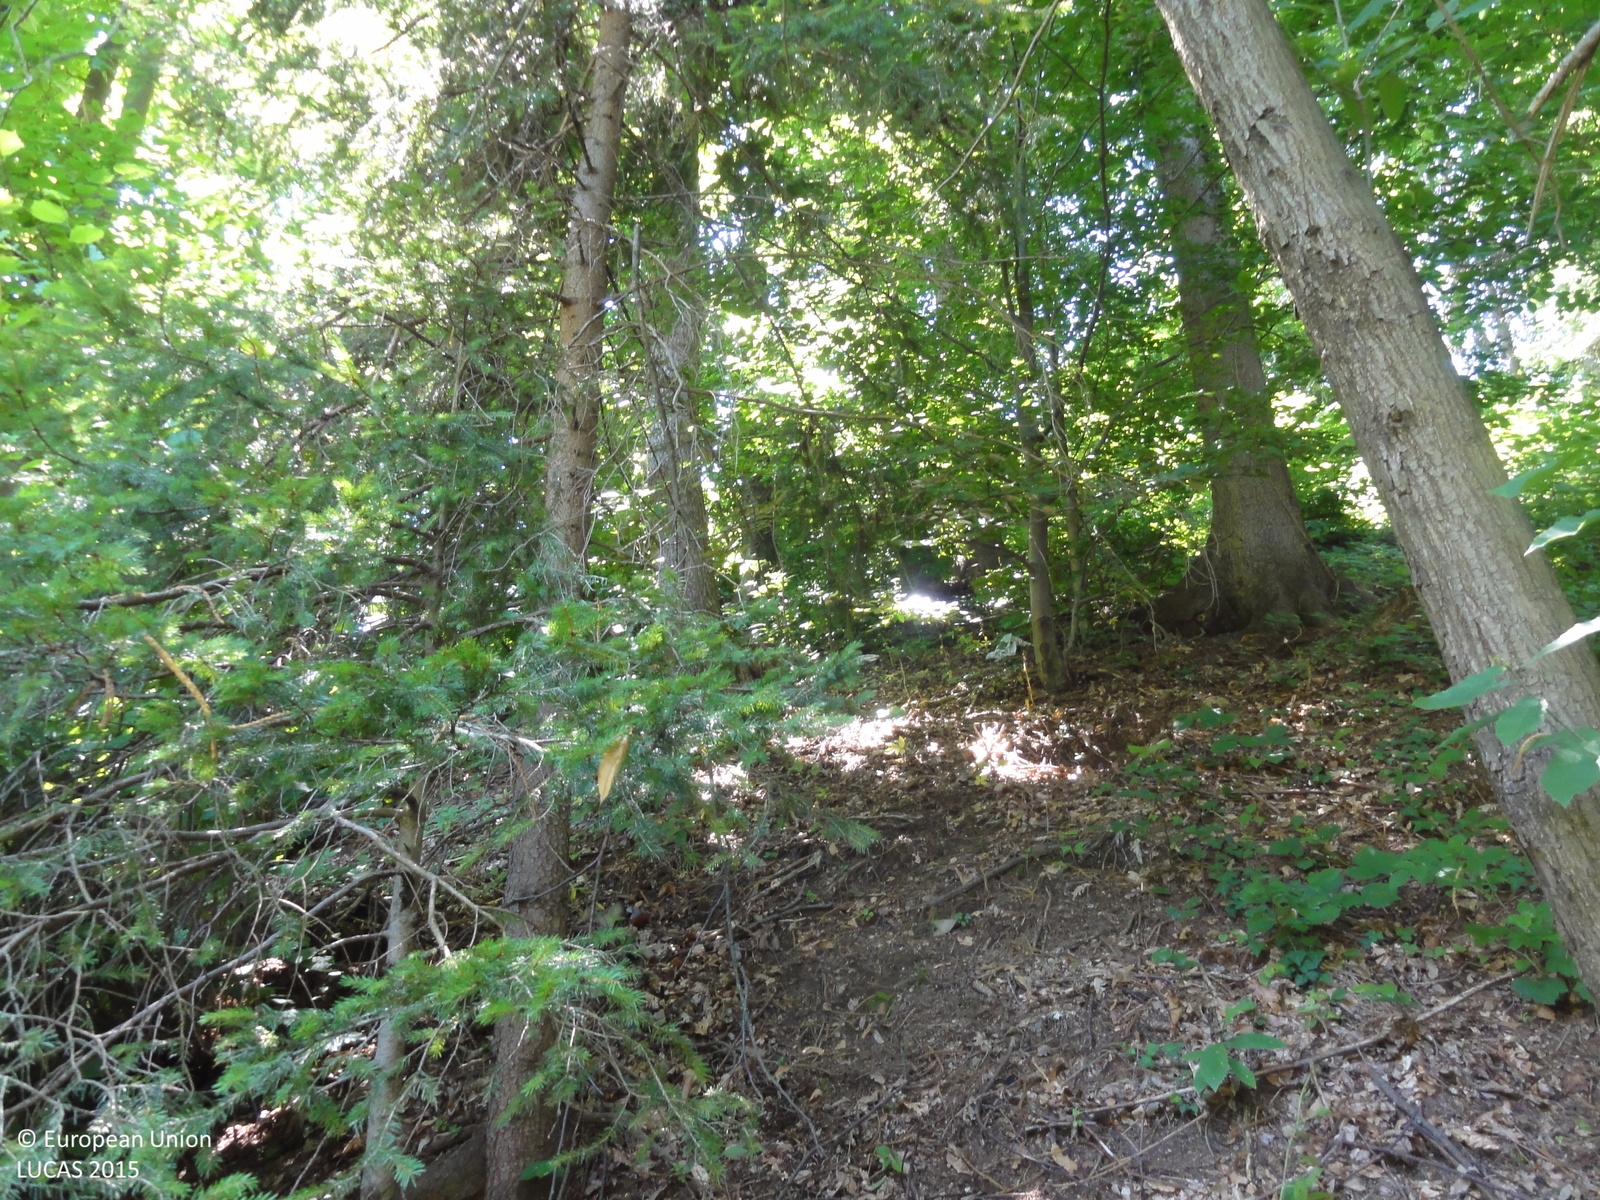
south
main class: Woodland
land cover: Spruce dominated mixed woodland
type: mesophytic deciduous forest
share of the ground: > 75 %
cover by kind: coniferous forest trees 50 %, broadleaved forest trees 50 %
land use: Forestry
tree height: > 5 m
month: July
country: SI
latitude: 46.3197
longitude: 15.1017
